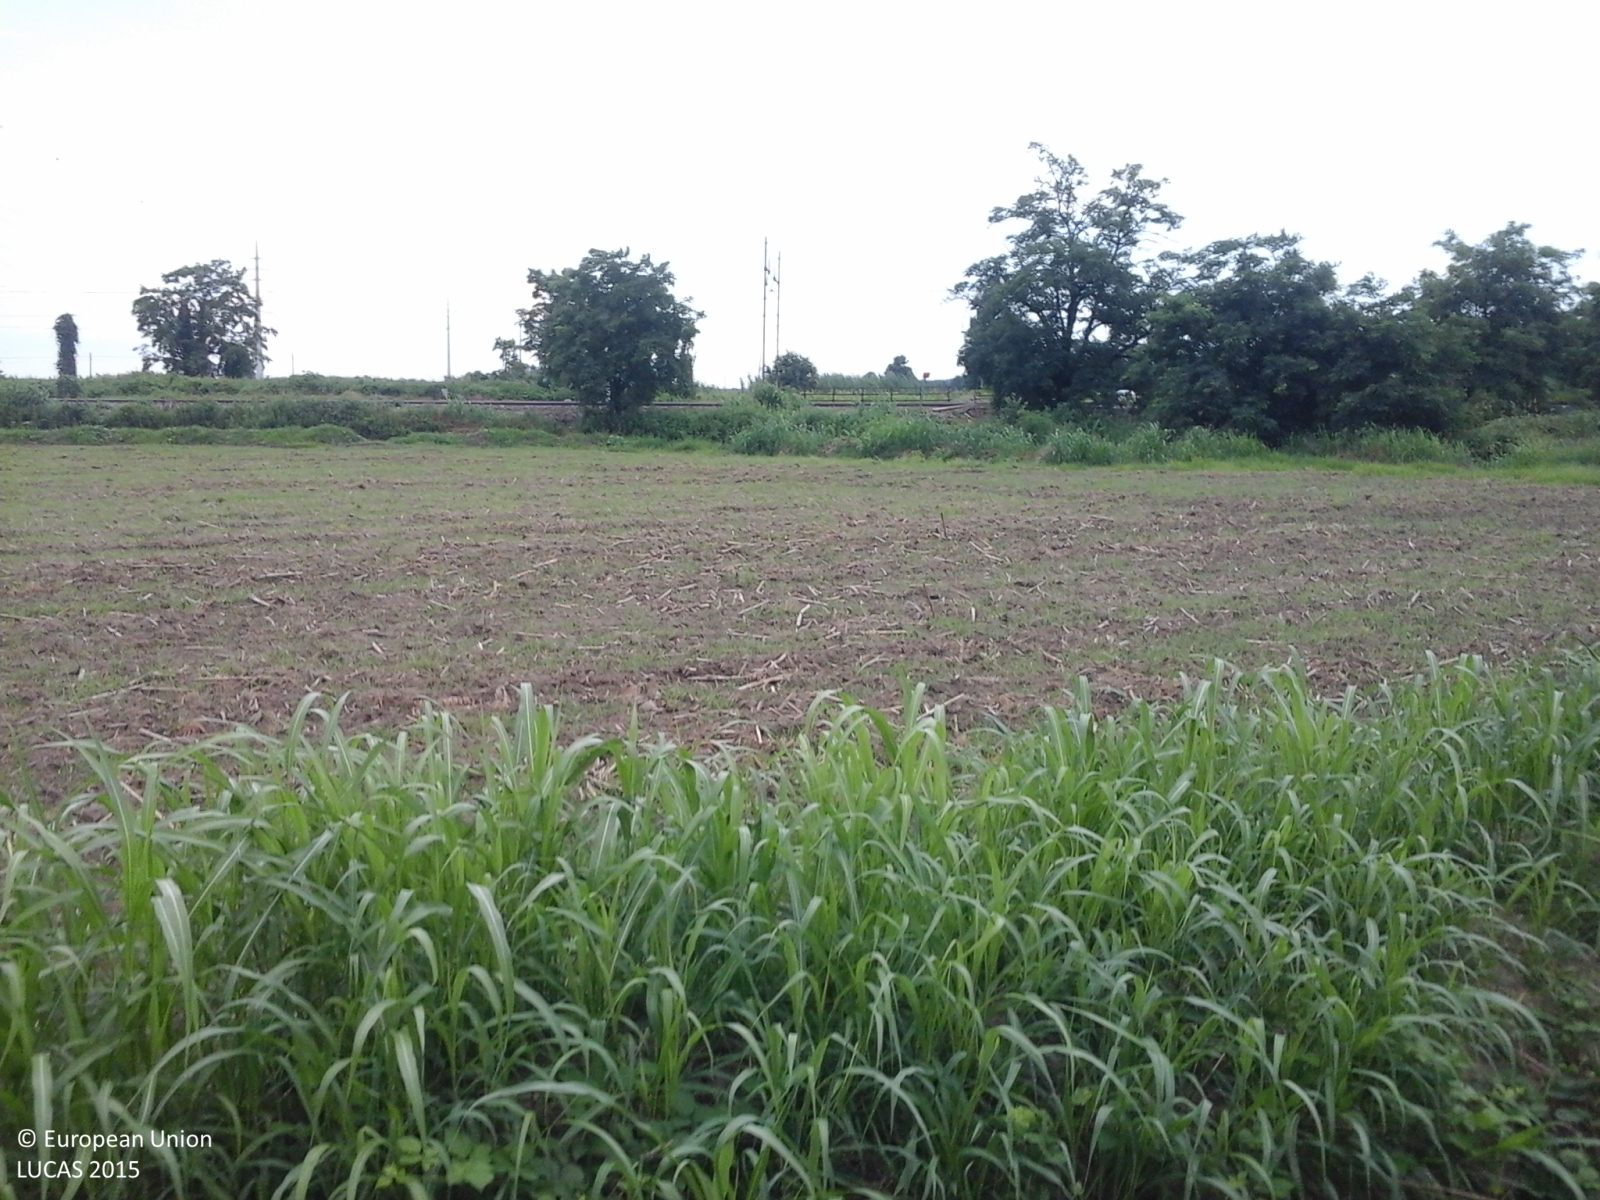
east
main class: Cropland
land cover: Rice
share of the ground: > 75 %
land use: Agriculture (excluding fallow land and kitchen gardens)
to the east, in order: Rice; Grass margins; Ditches and canals; Grass margins; Rice; Grass margins; Ditches and canals; Shrubland without tree cover; Electric lines; Railways; Grass margins; Rice
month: June
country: IT
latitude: 45.2262
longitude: 8.7160
